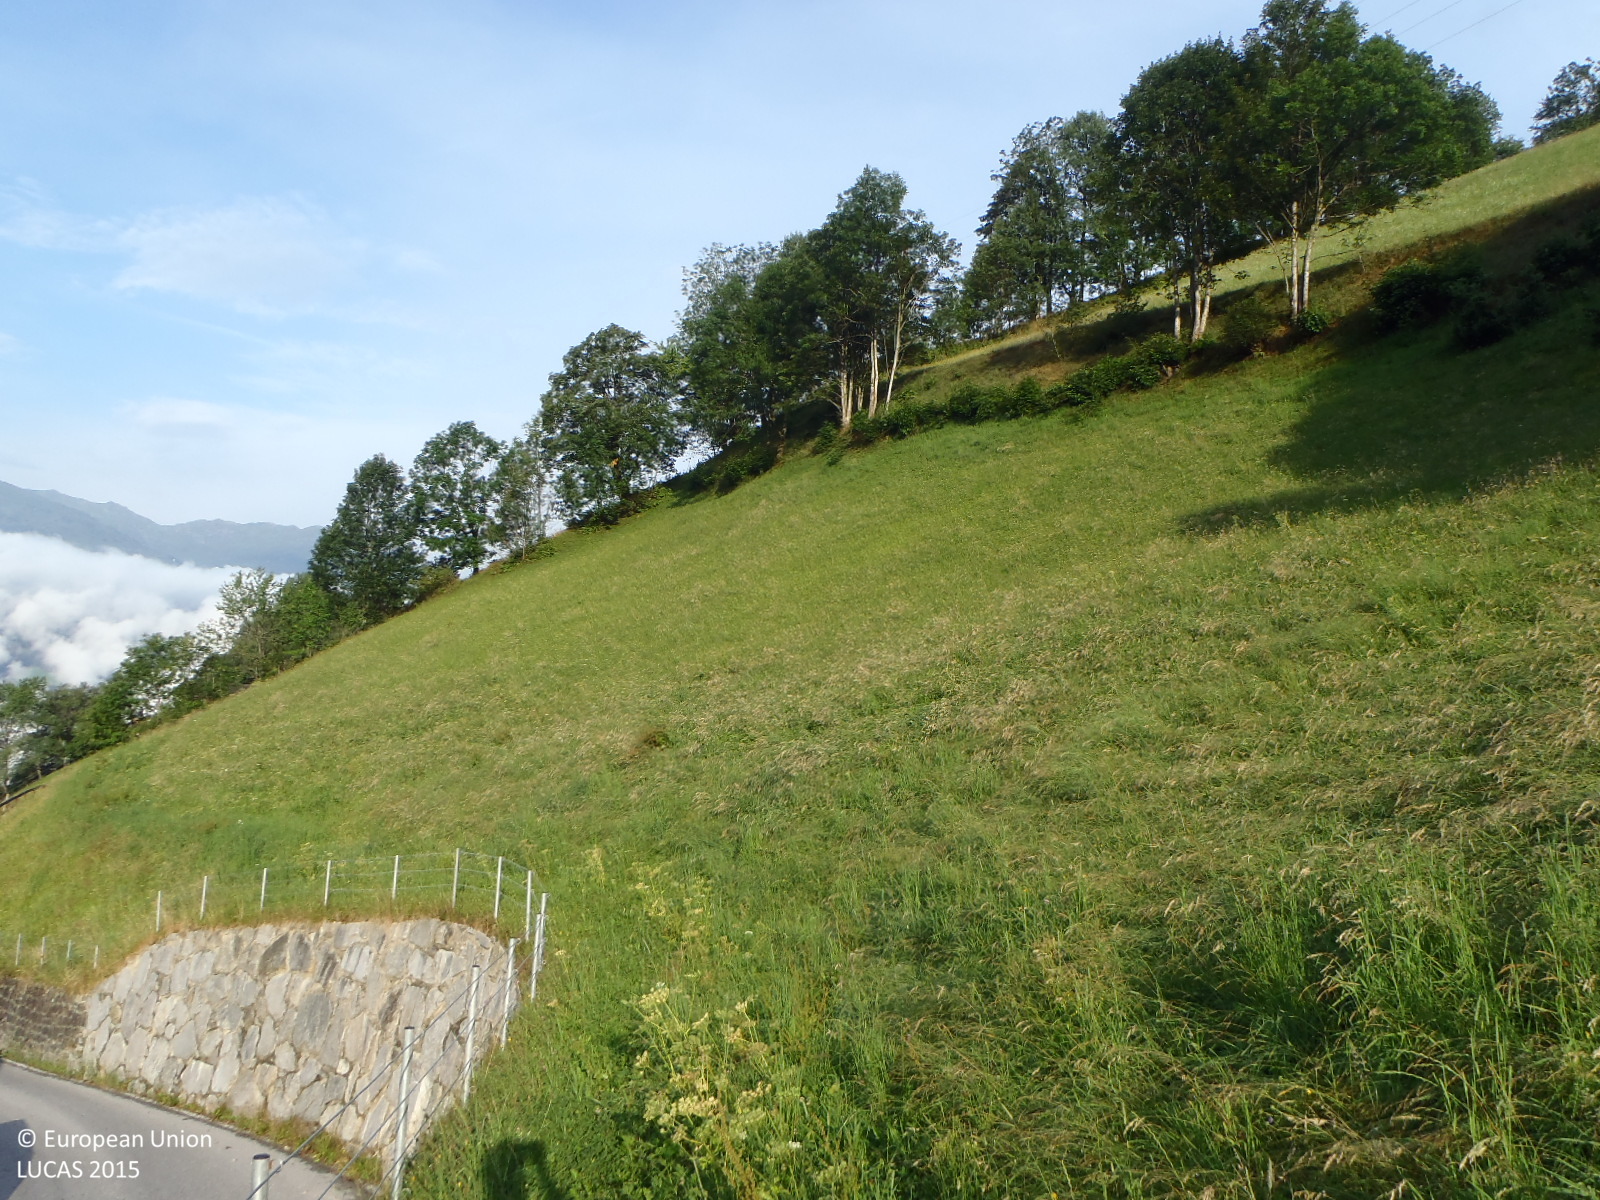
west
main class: Grassland
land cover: Grassland without tree/shrub cover
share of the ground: > 75 %
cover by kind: herbaceous plants 100 %
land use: Agriculture (excluding fallow land and kitchen gardens)
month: July
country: AT
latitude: 47.3067
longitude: 11.9163
